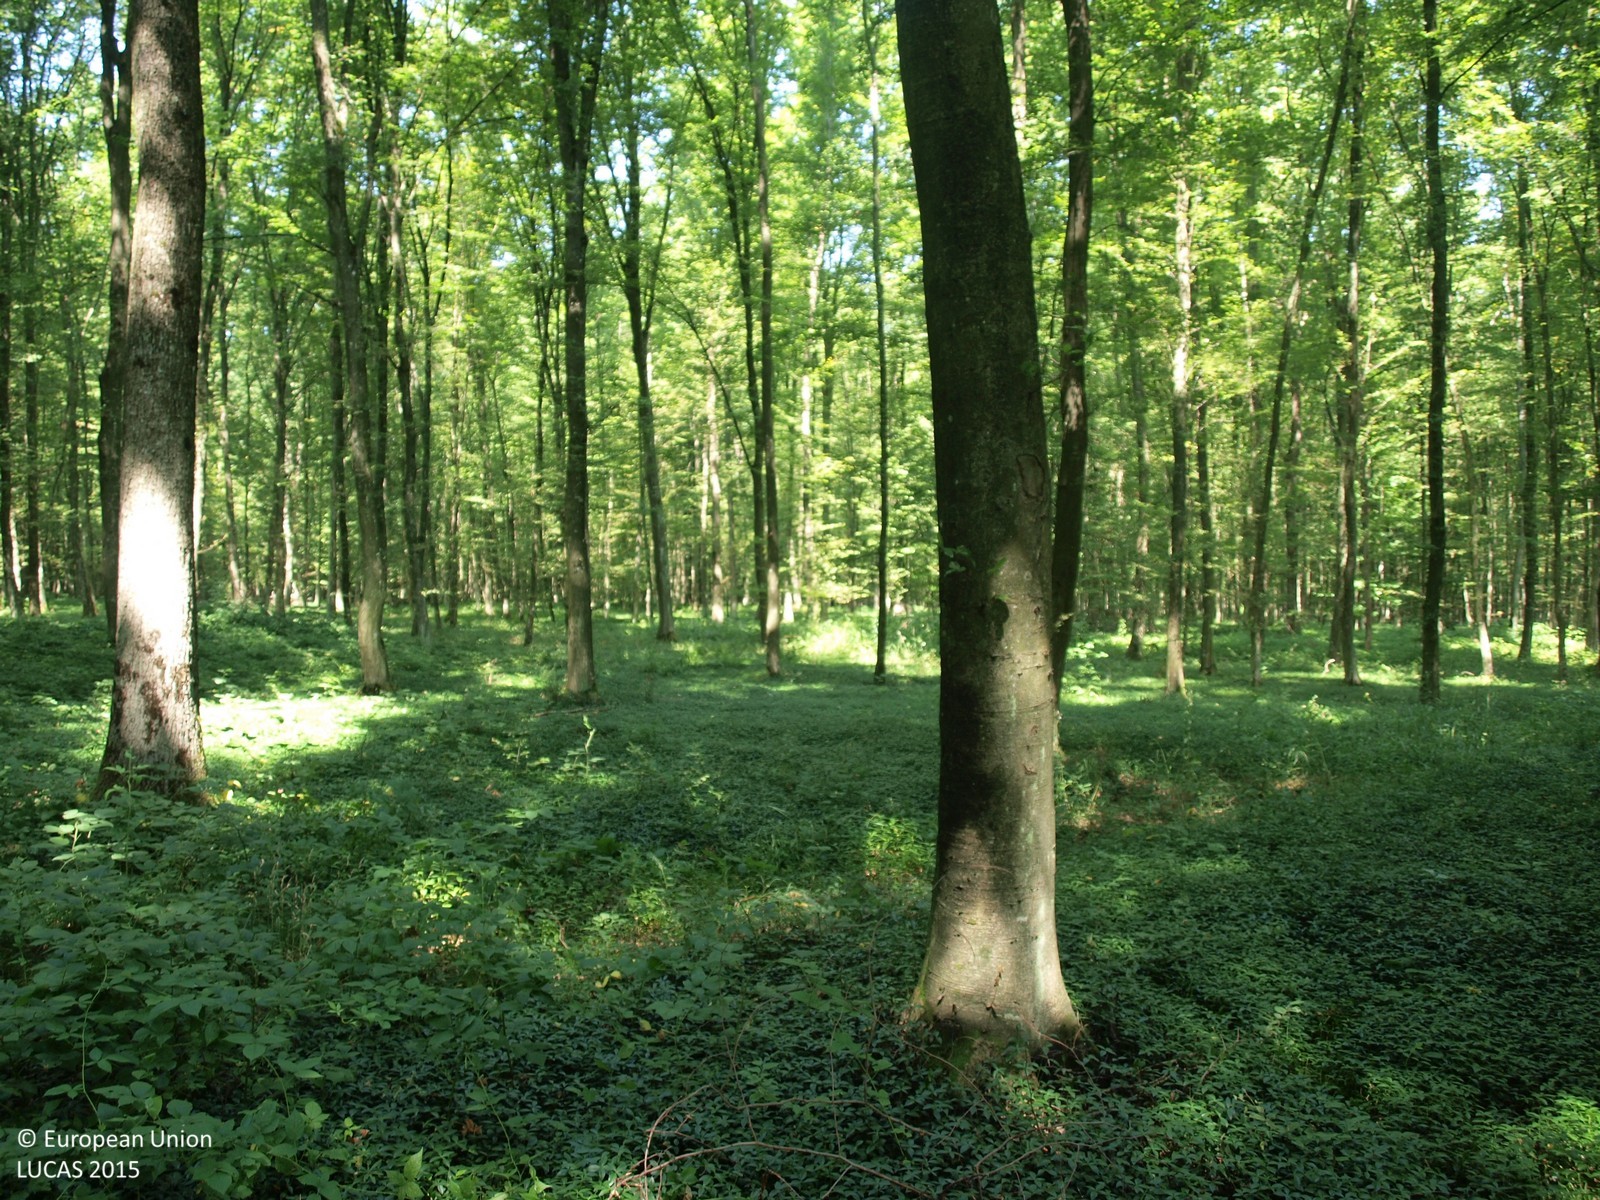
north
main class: Woodland
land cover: Broadleaved woodland
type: mesophytic deciduous forest
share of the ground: > 75 %
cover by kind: broadleaved forest trees 100 %
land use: Forestry
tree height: > 5 m
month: August
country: HR
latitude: 45.8757
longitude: 16.6090
